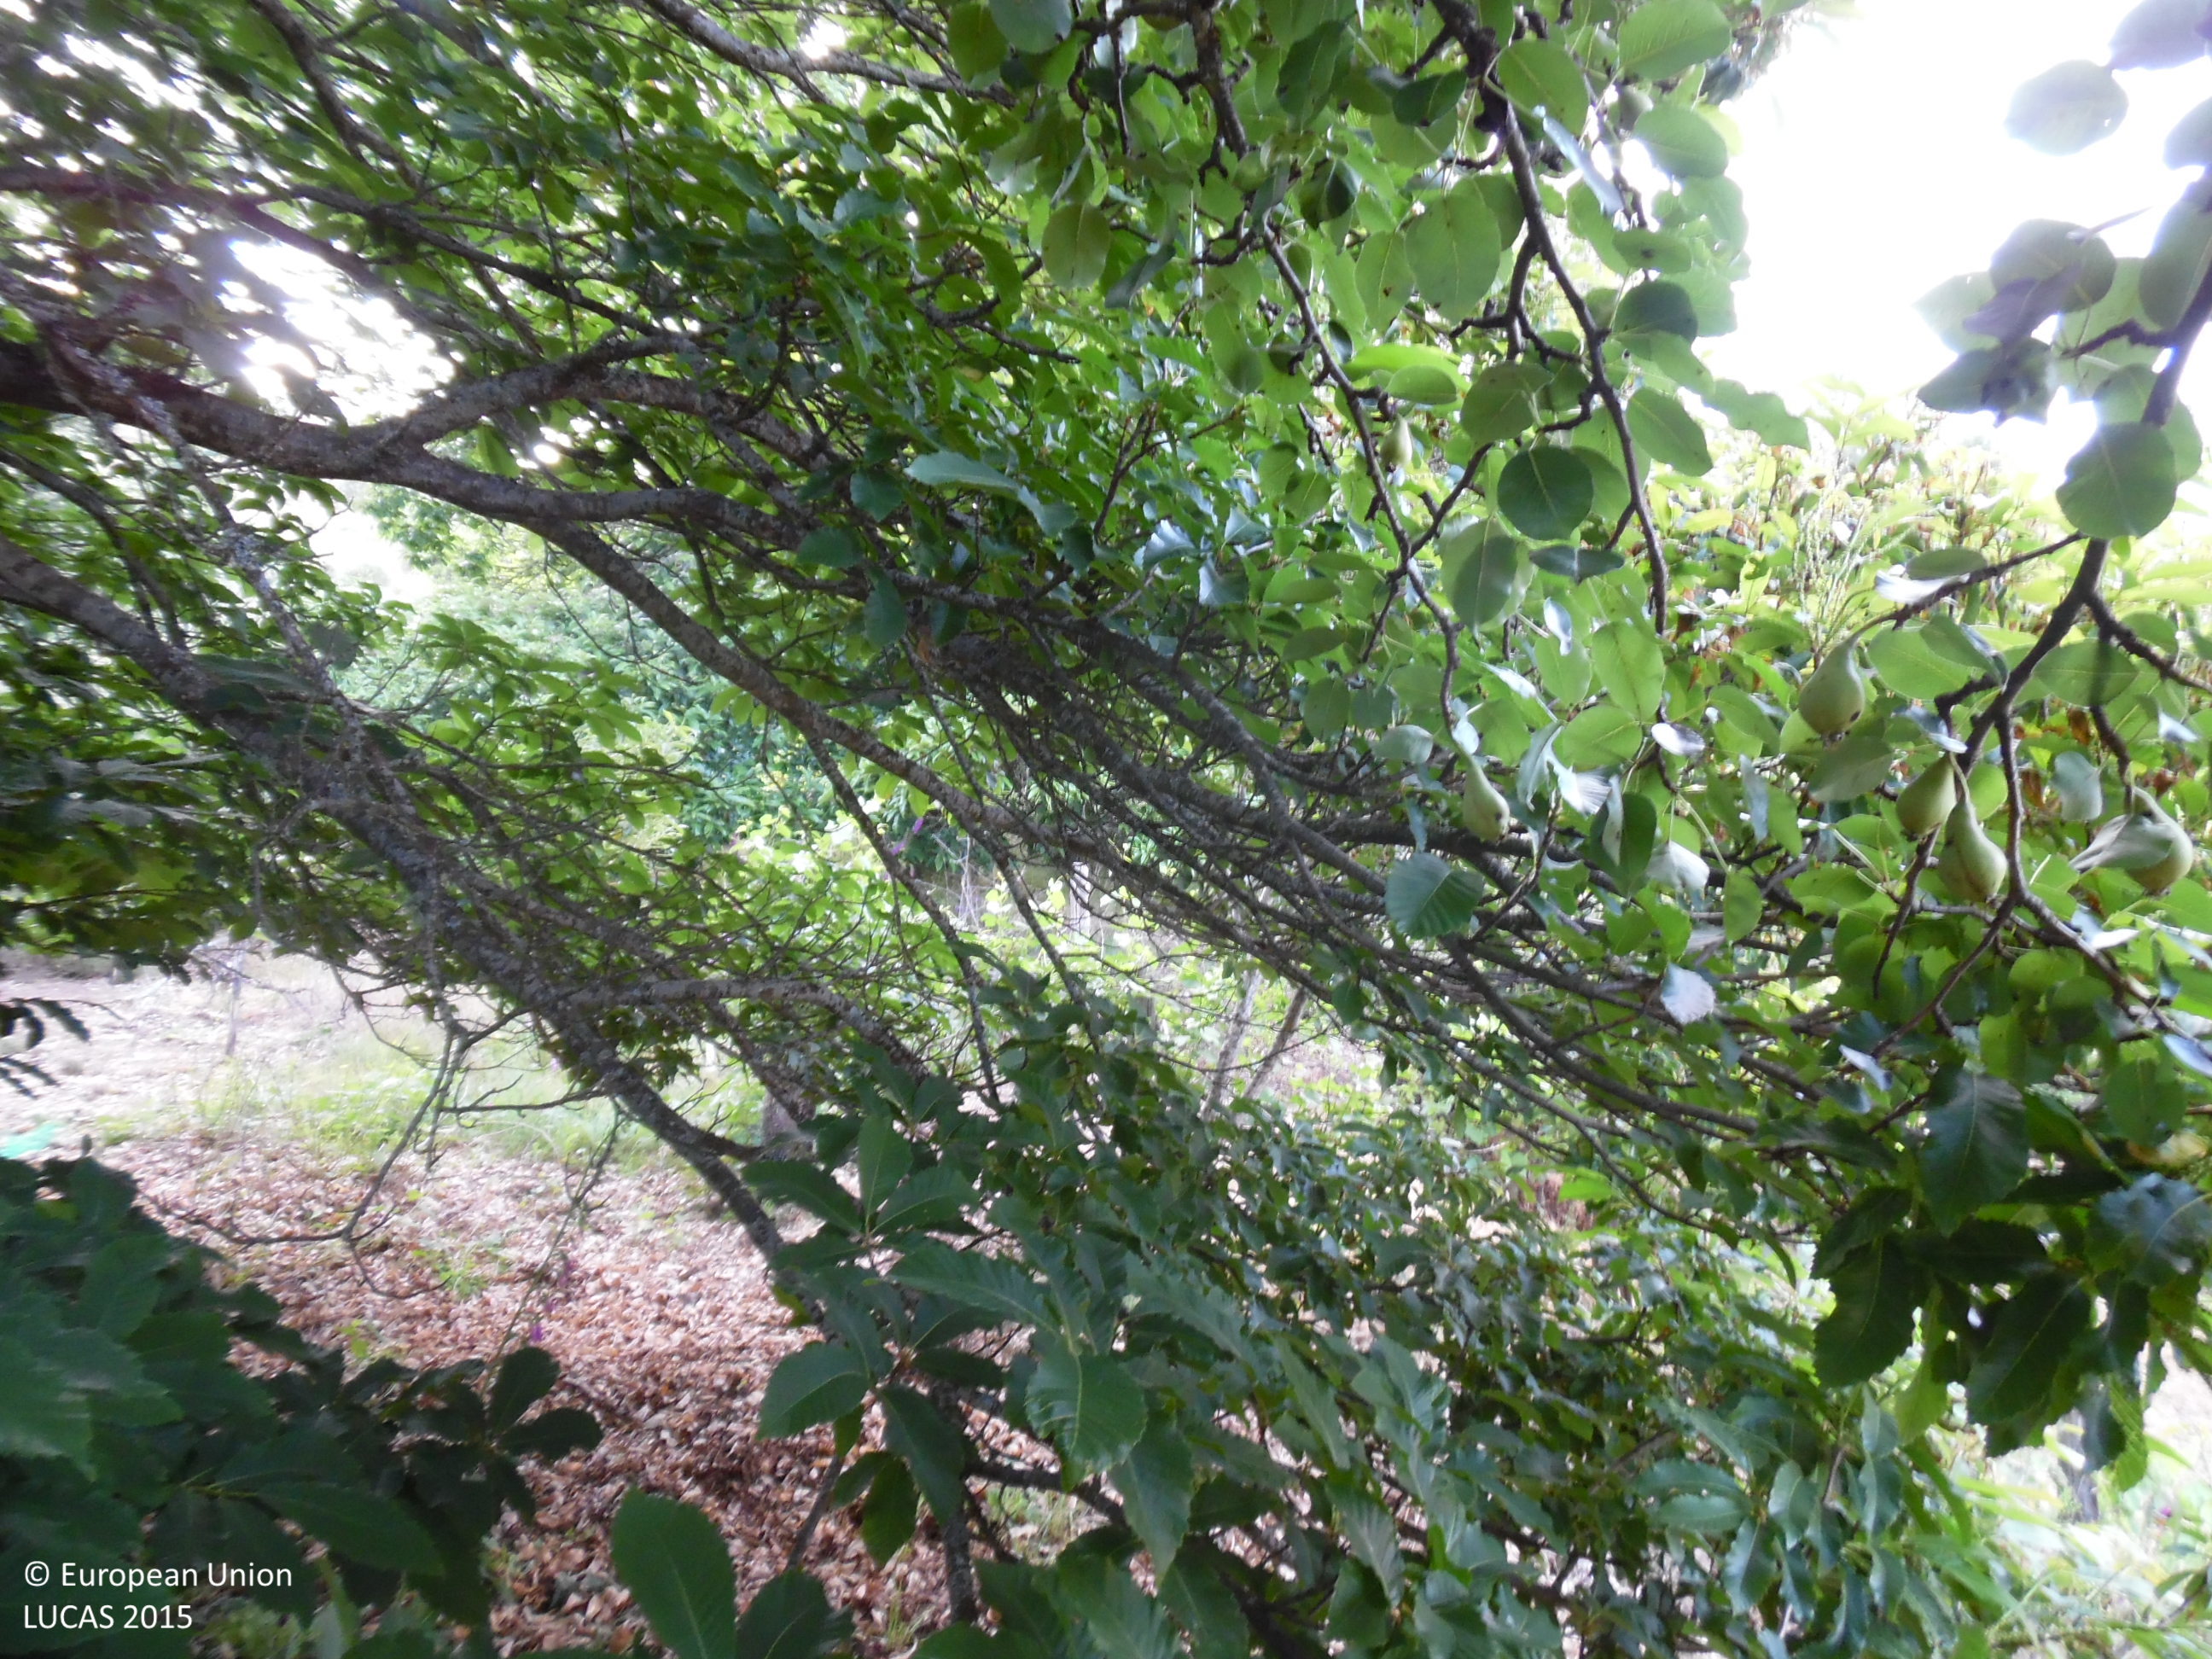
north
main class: Woodland
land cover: Broadleaved woodland
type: thermophilous deciduous forest
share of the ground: > 75 %
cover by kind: broadleaved forest trees 90 %, shrubs 5 %, herbaceous plants 5 %
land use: Forestry
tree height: > 5 m
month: June
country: ES
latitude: 42.6847
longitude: -5.8355
